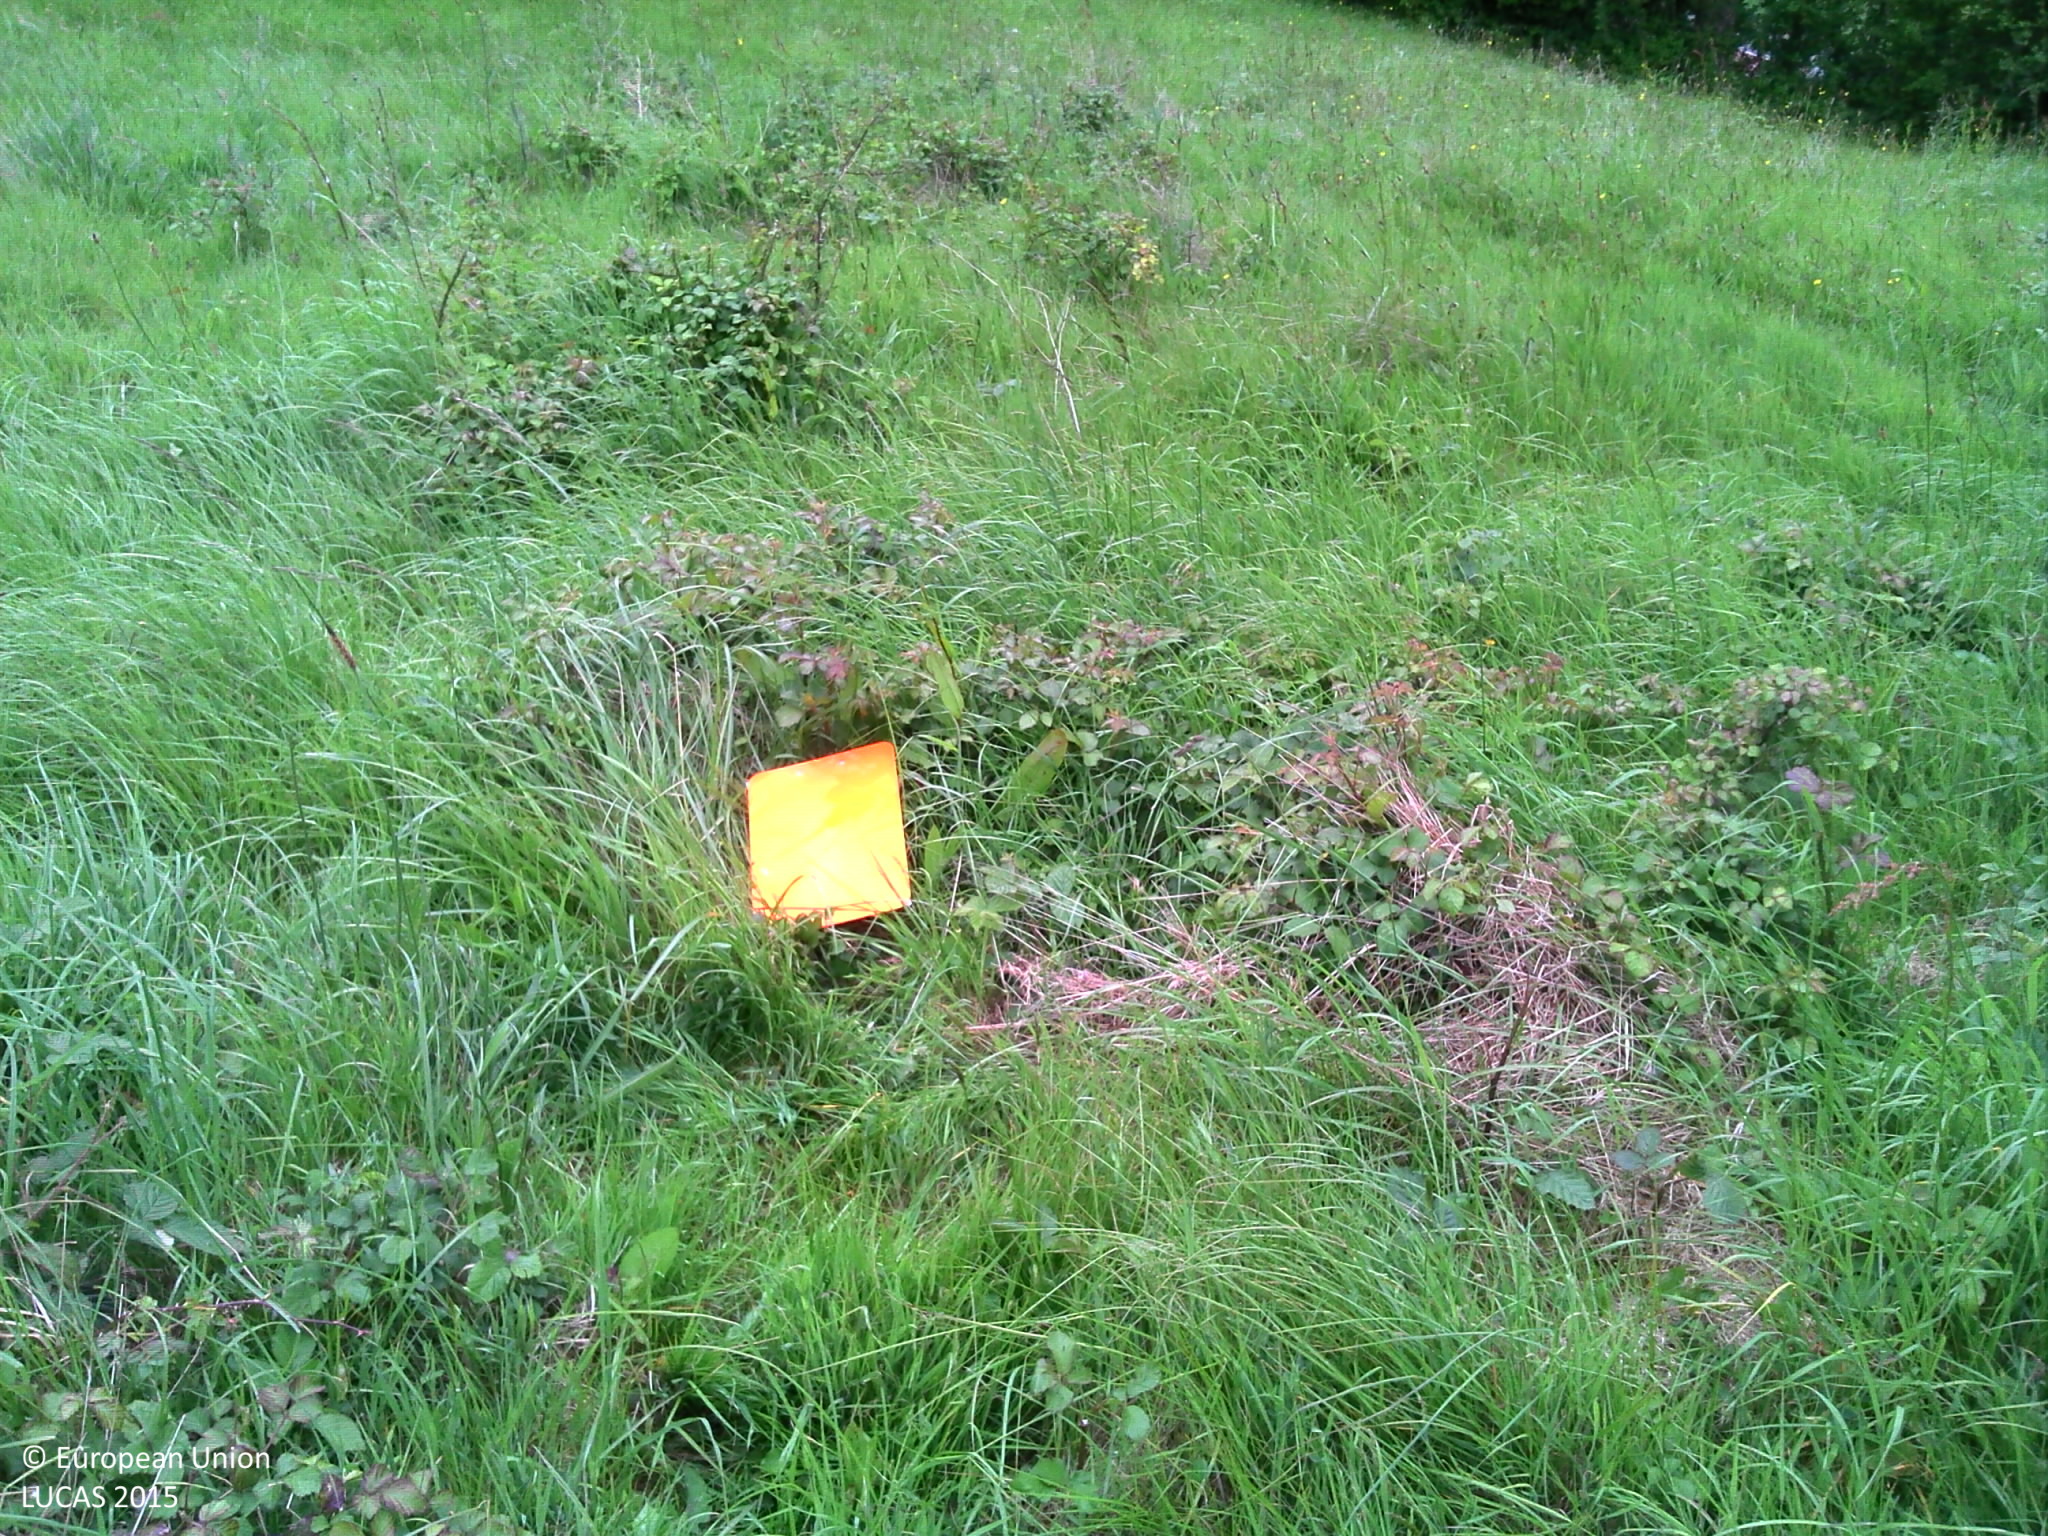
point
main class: Cropland
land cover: Pear fruit
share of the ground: < 10 %
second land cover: Grassland without tree/shrub cover
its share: > 75 %
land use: Agriculture (excluding fallow land and kitchen gardens)
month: May
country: FR
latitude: 49.2905
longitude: 0.0006
